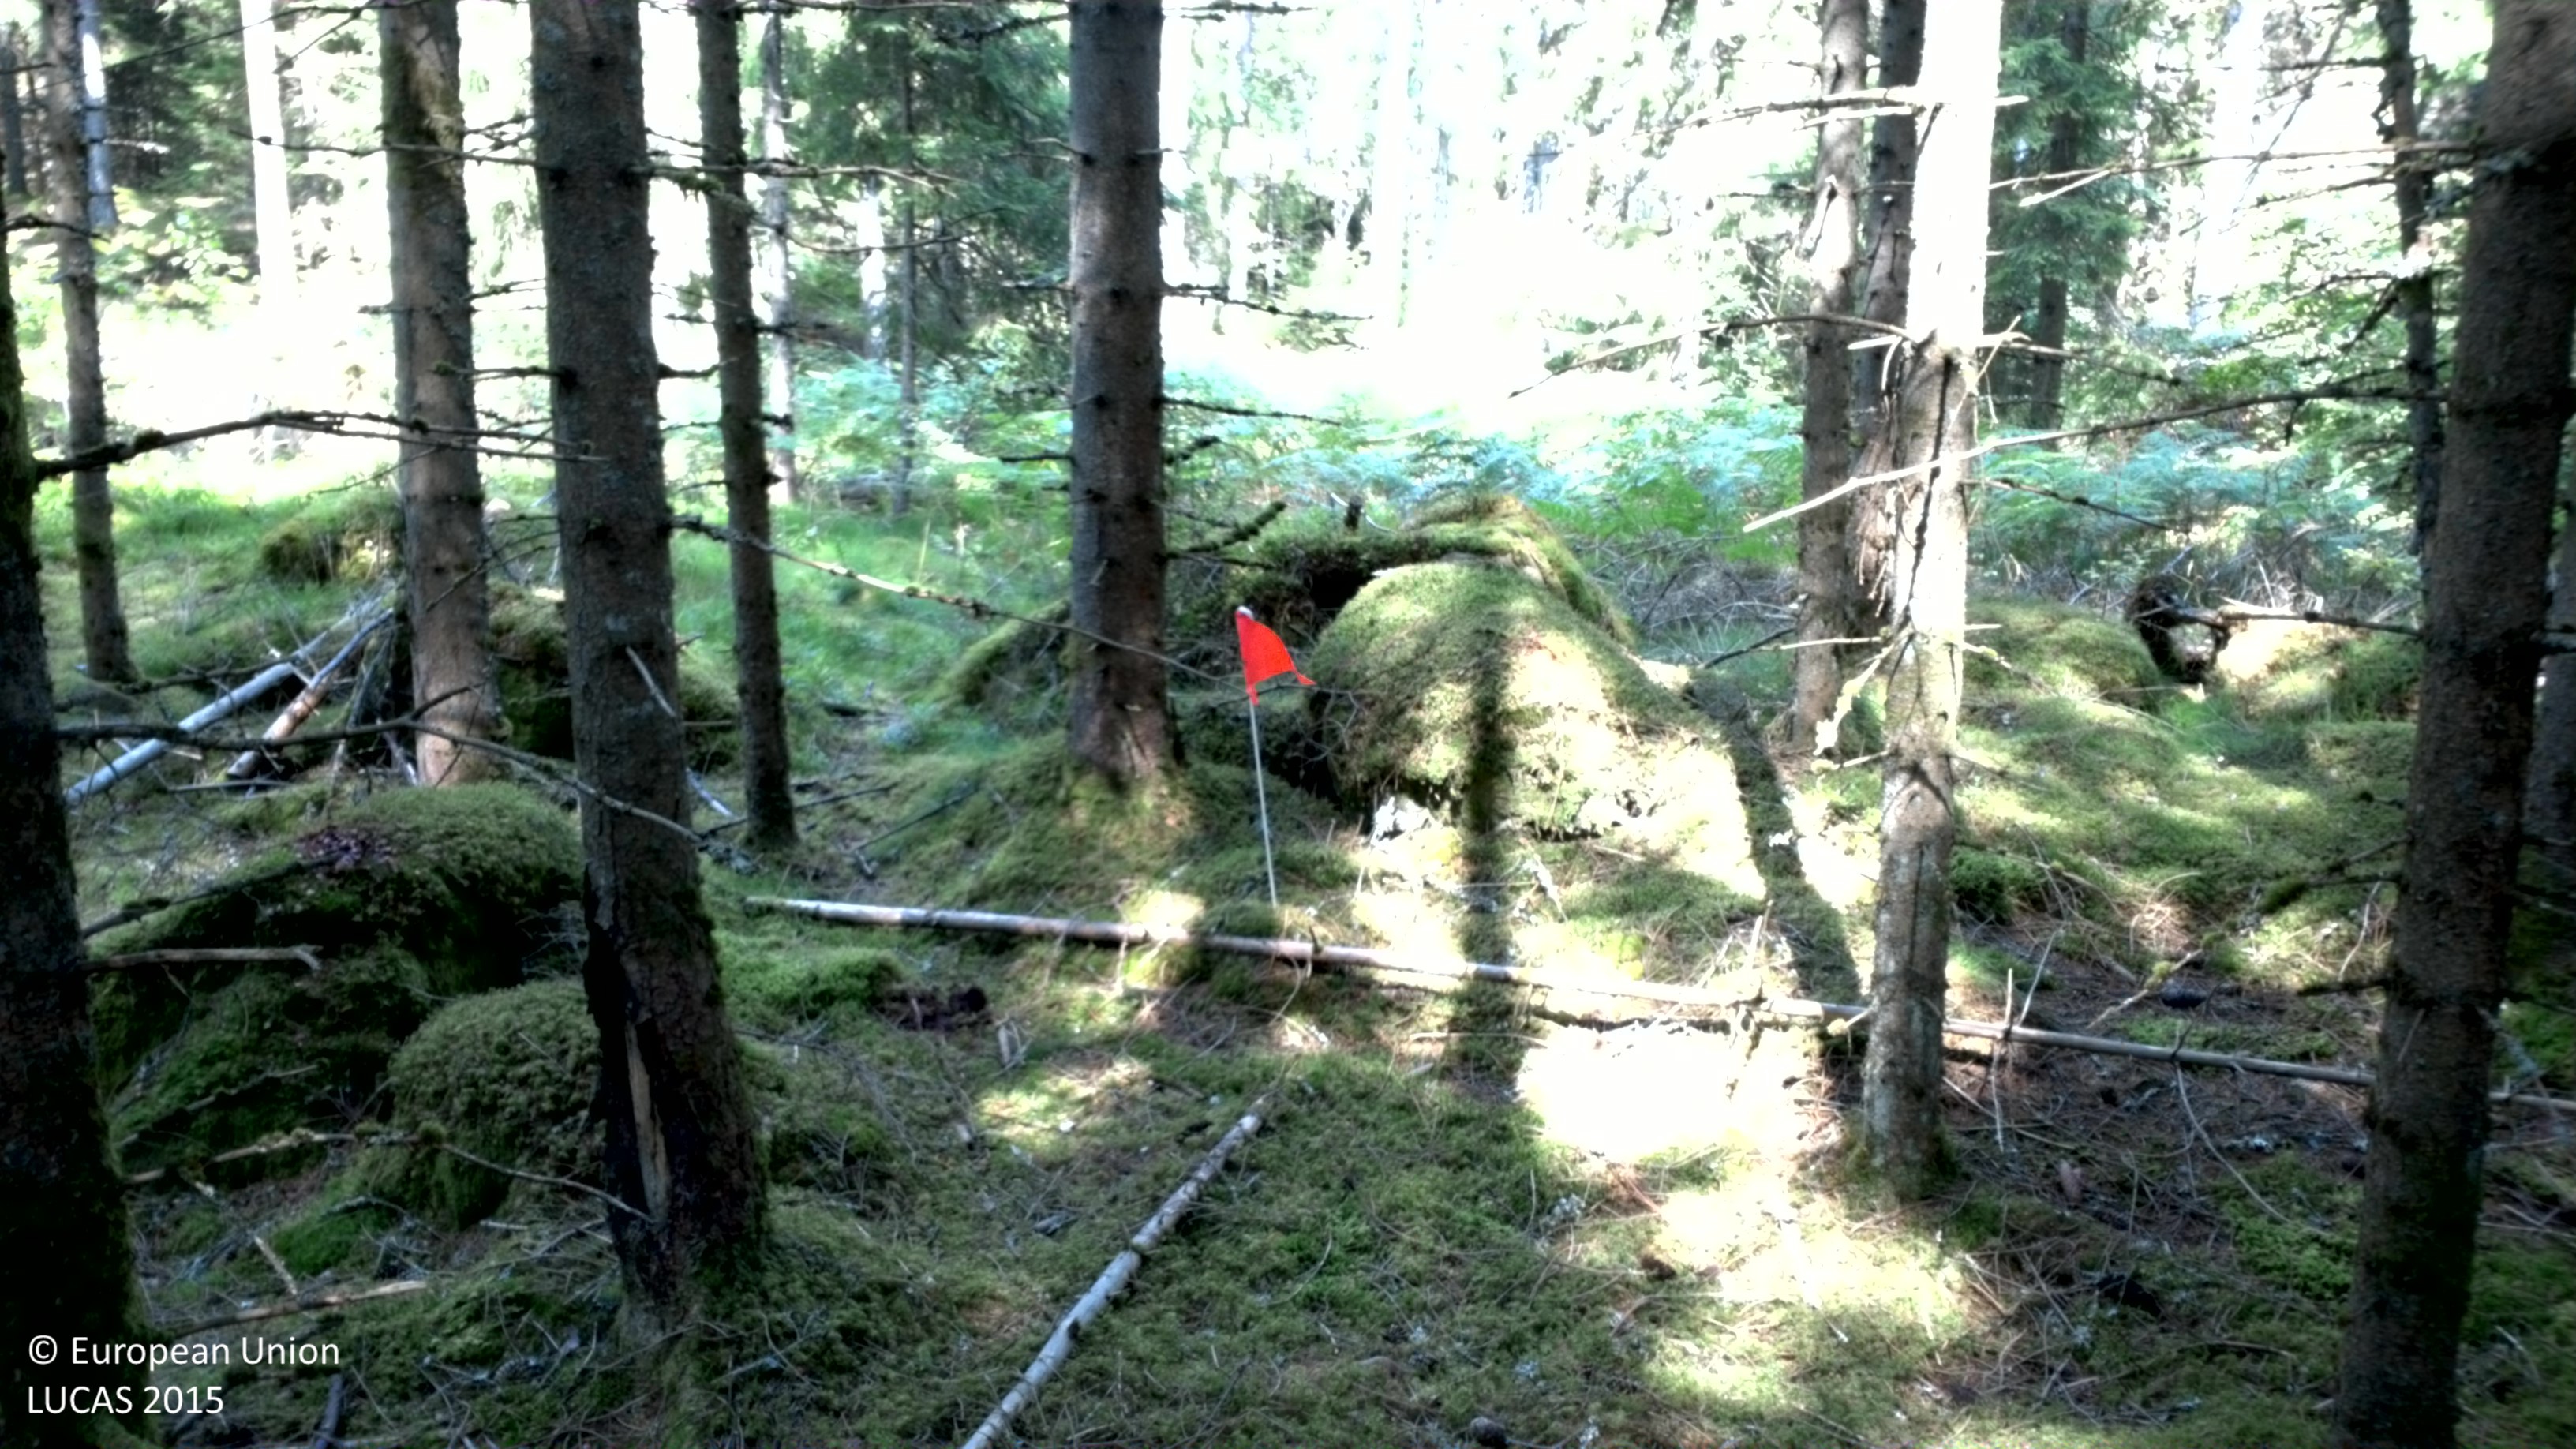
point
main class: Woodland
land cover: Spruce dominated coniferous woodland
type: boreal forest
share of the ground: 50 - 75 %
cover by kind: coniferous forest trees 70 %, lichens and mosses 15 %, herbaceous plants 10 %, shrubs 5 %
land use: Forestry
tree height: > 5 m
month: August
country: SE
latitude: 56.4242
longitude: 14.2290
